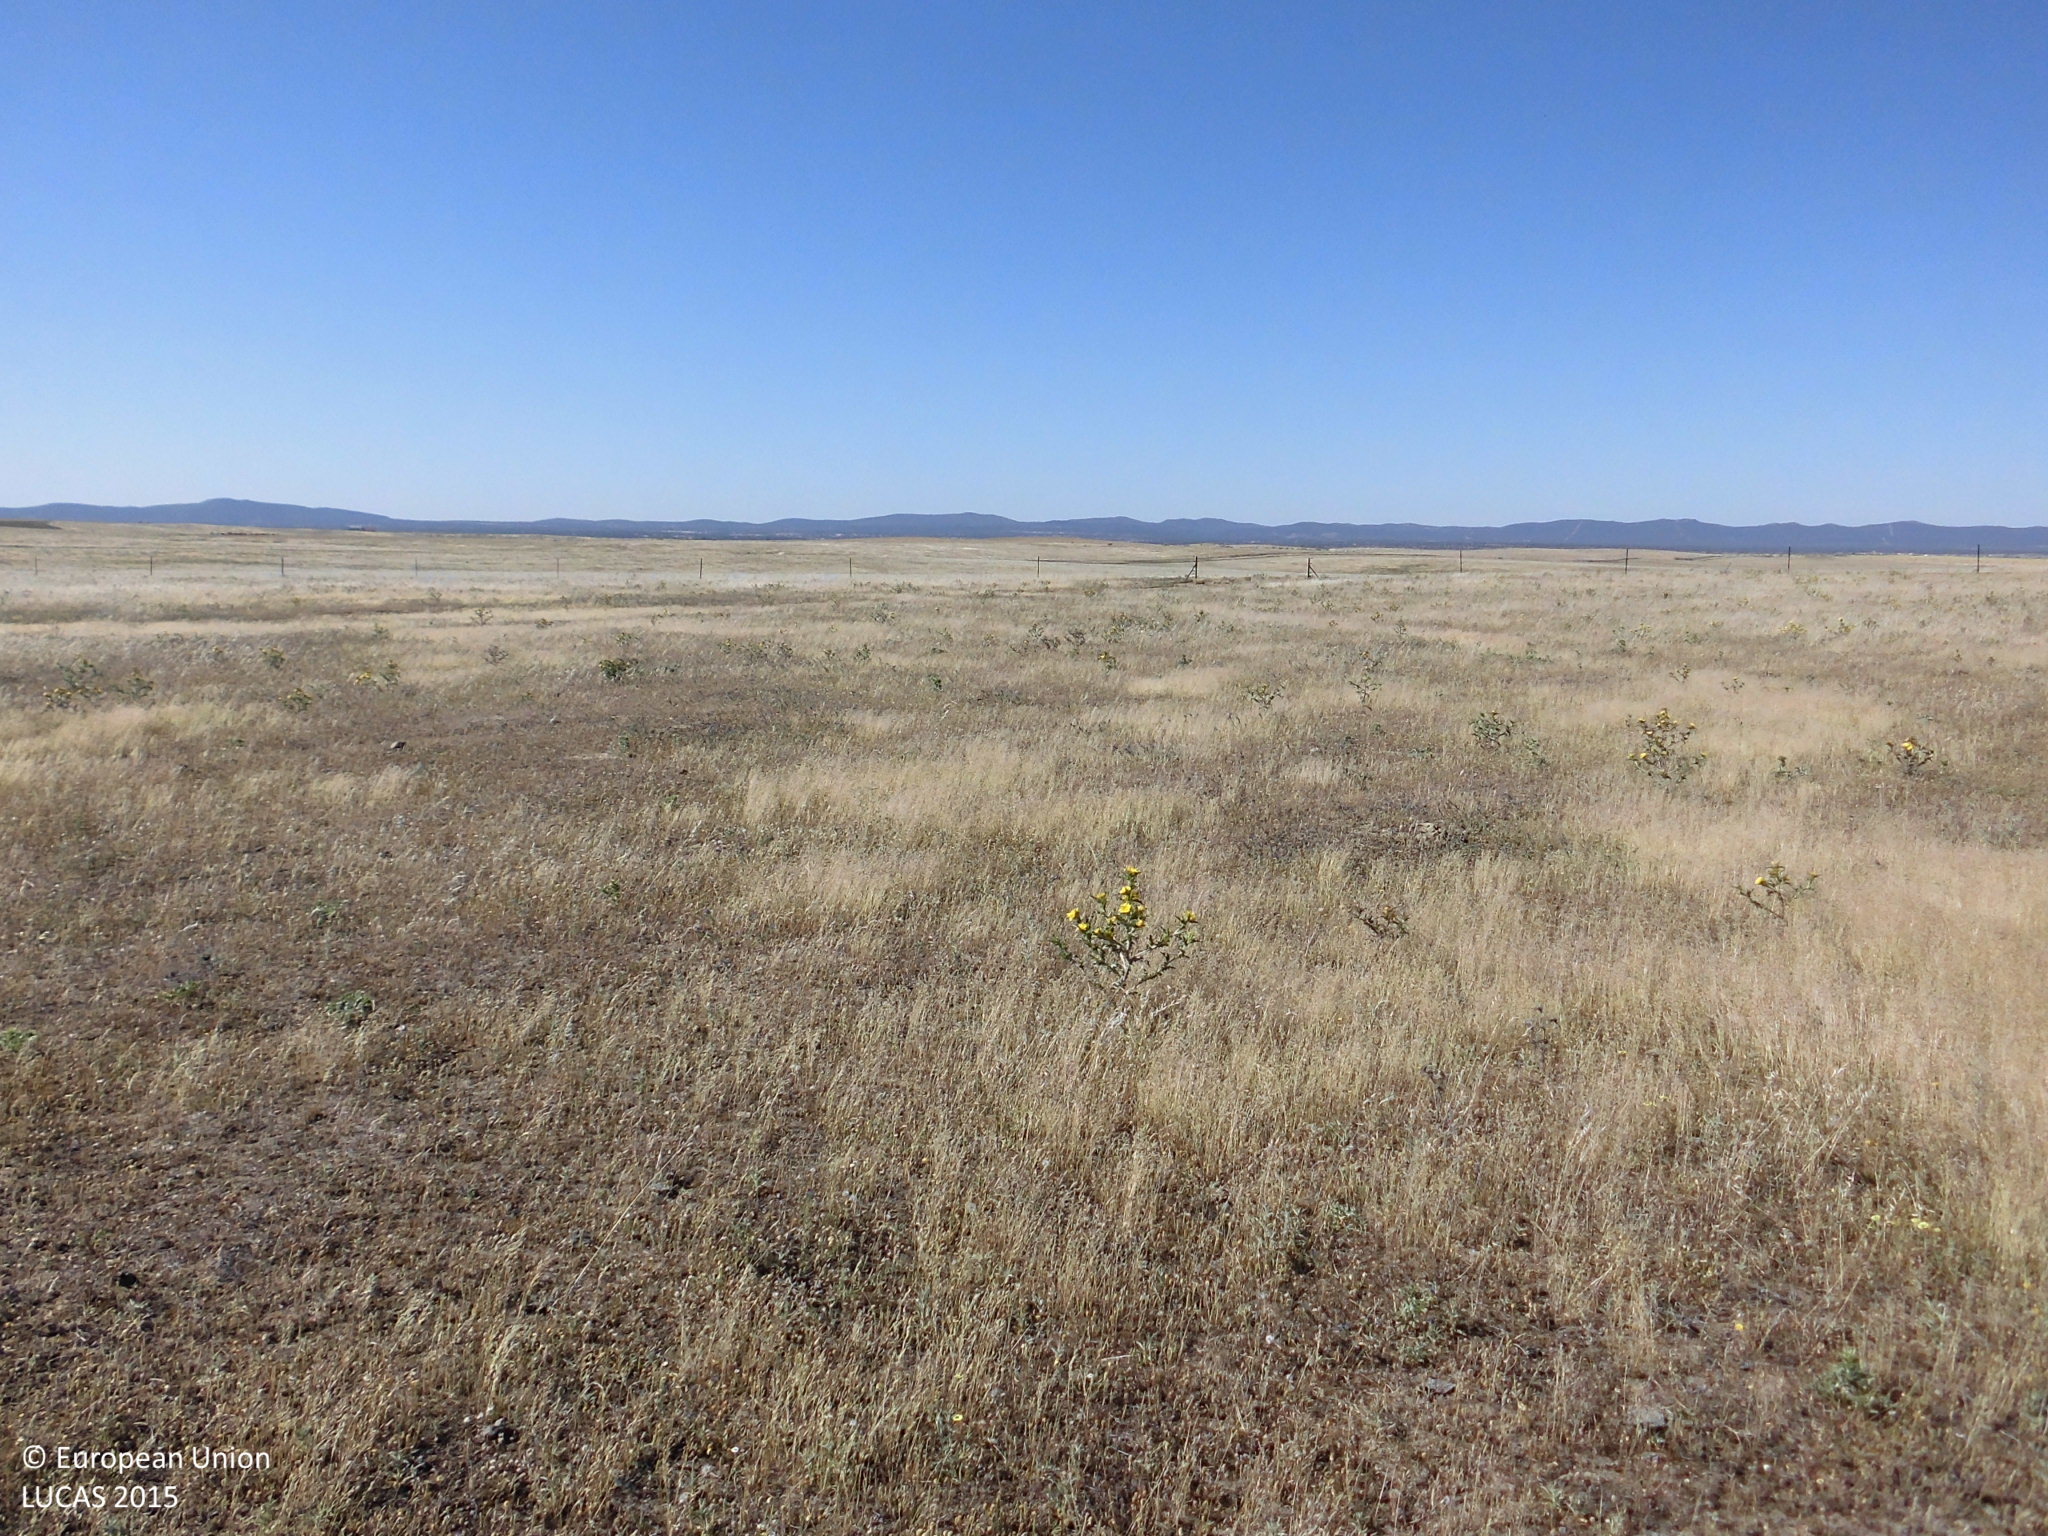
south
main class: Grassland
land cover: Grassland without tree/shrub cover
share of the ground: > 75 %
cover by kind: herbaceous plants 100 %
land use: Agriculture (excluding fallow land and kitchen gardens)
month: May
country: ES
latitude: 39.5364
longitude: -6.8450
